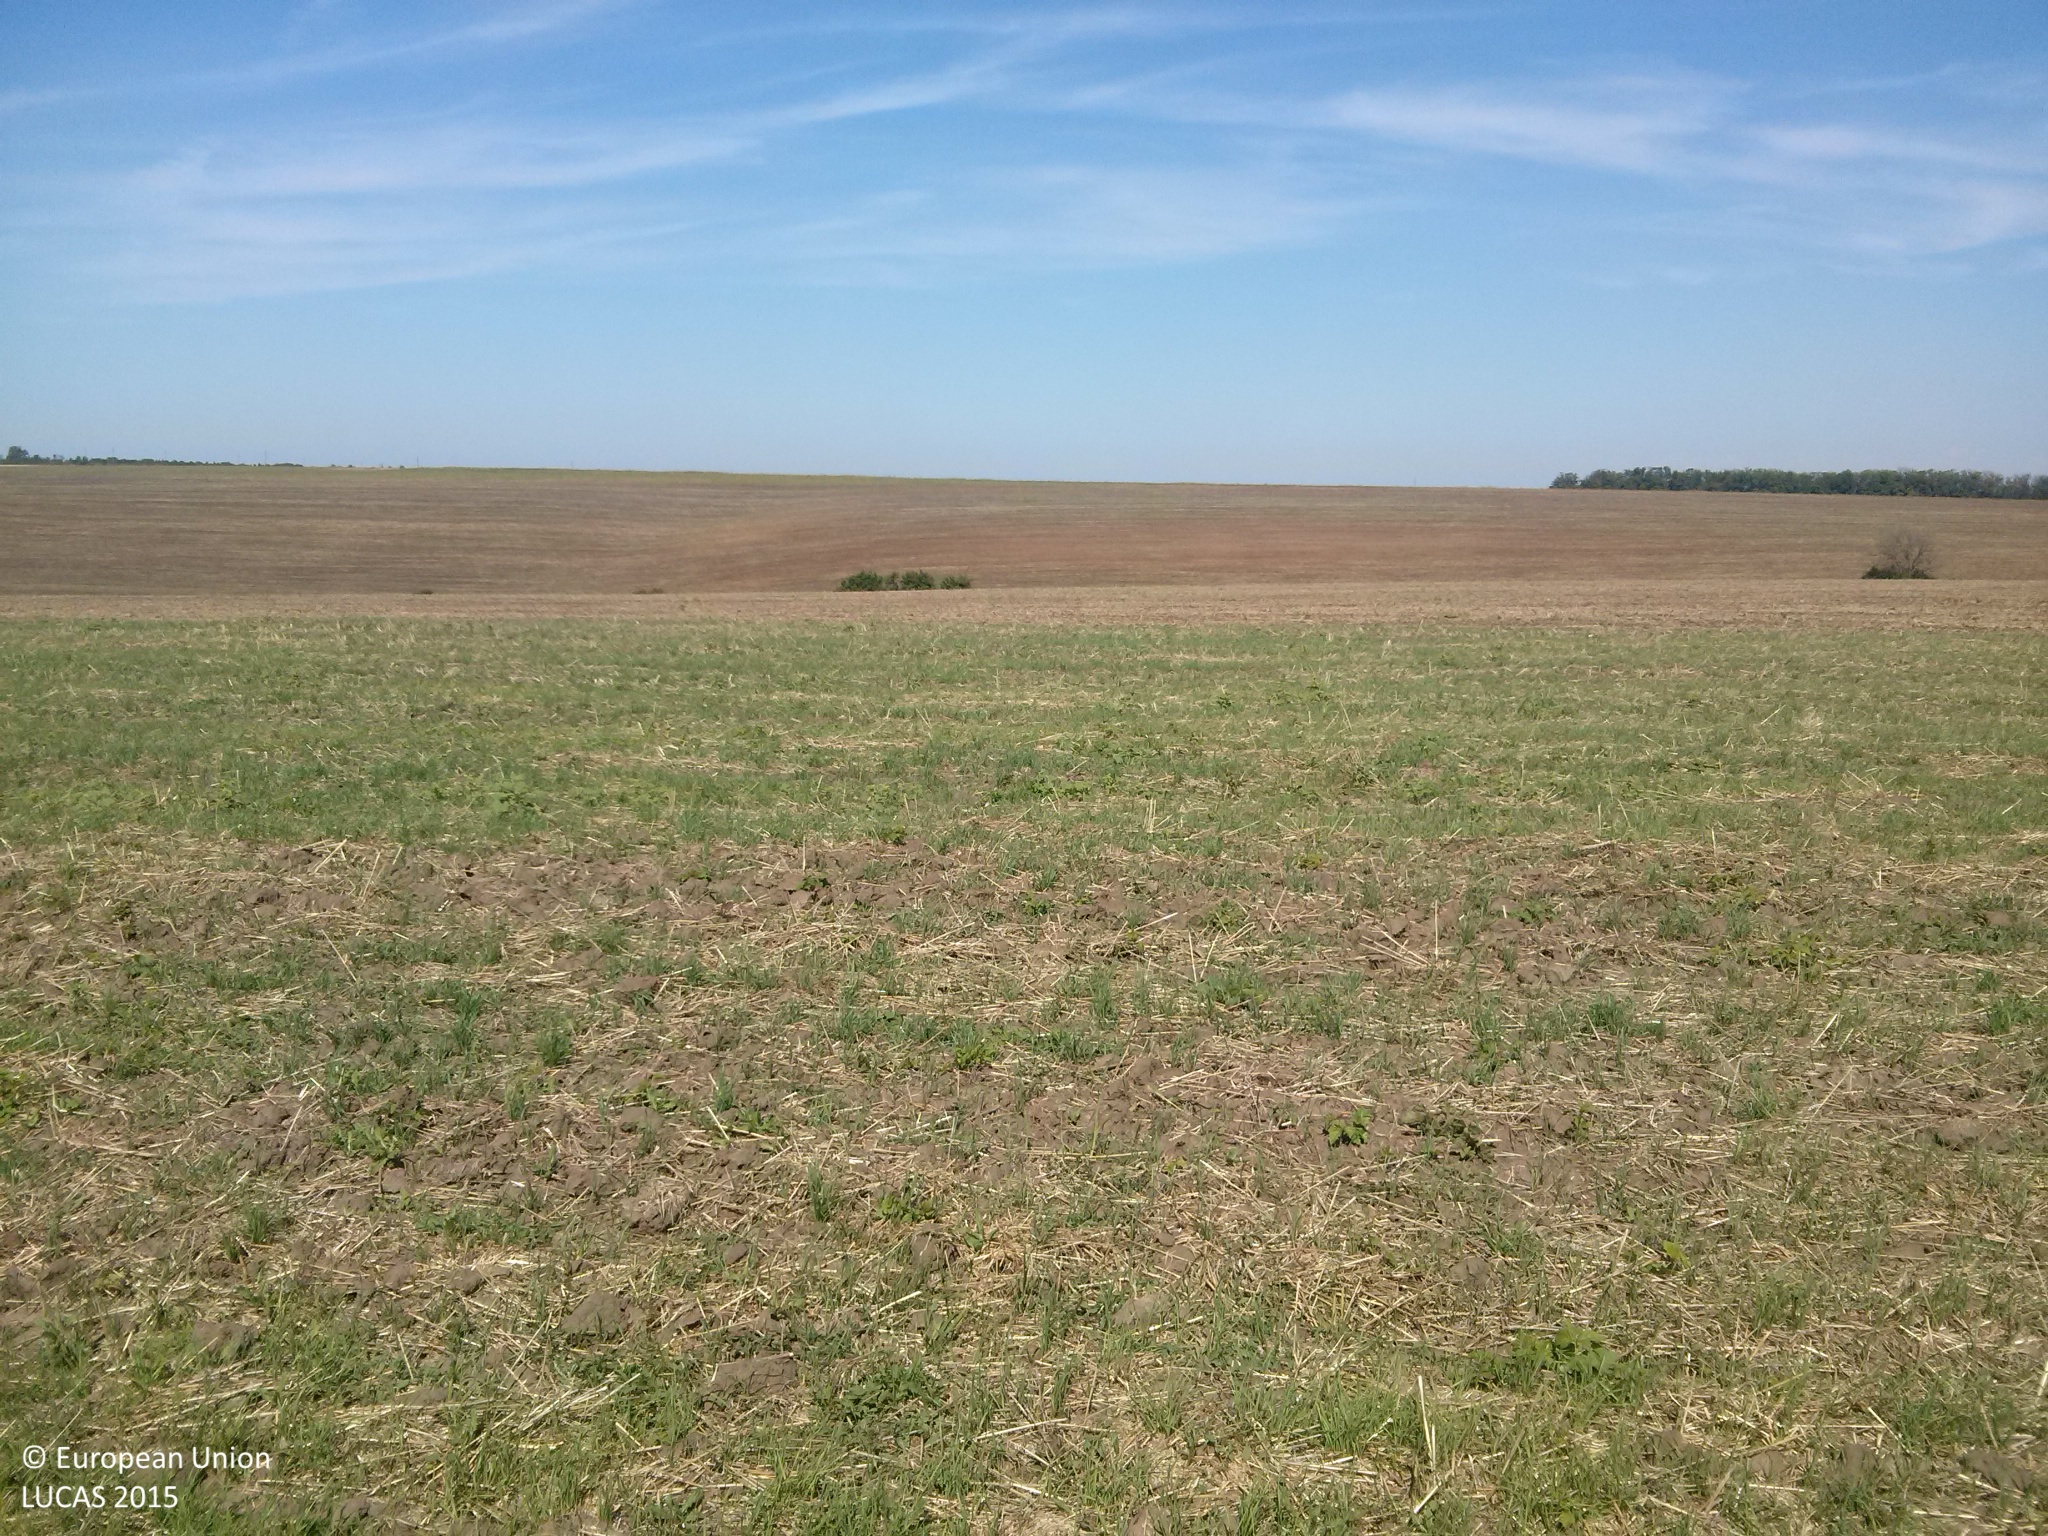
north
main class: Cropland
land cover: Common wheat
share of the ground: < 10 %
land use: Agriculture (excluding fallow land and kitchen gardens)
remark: Harvested field
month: September
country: BG
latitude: 43.6757
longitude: 26.4152
